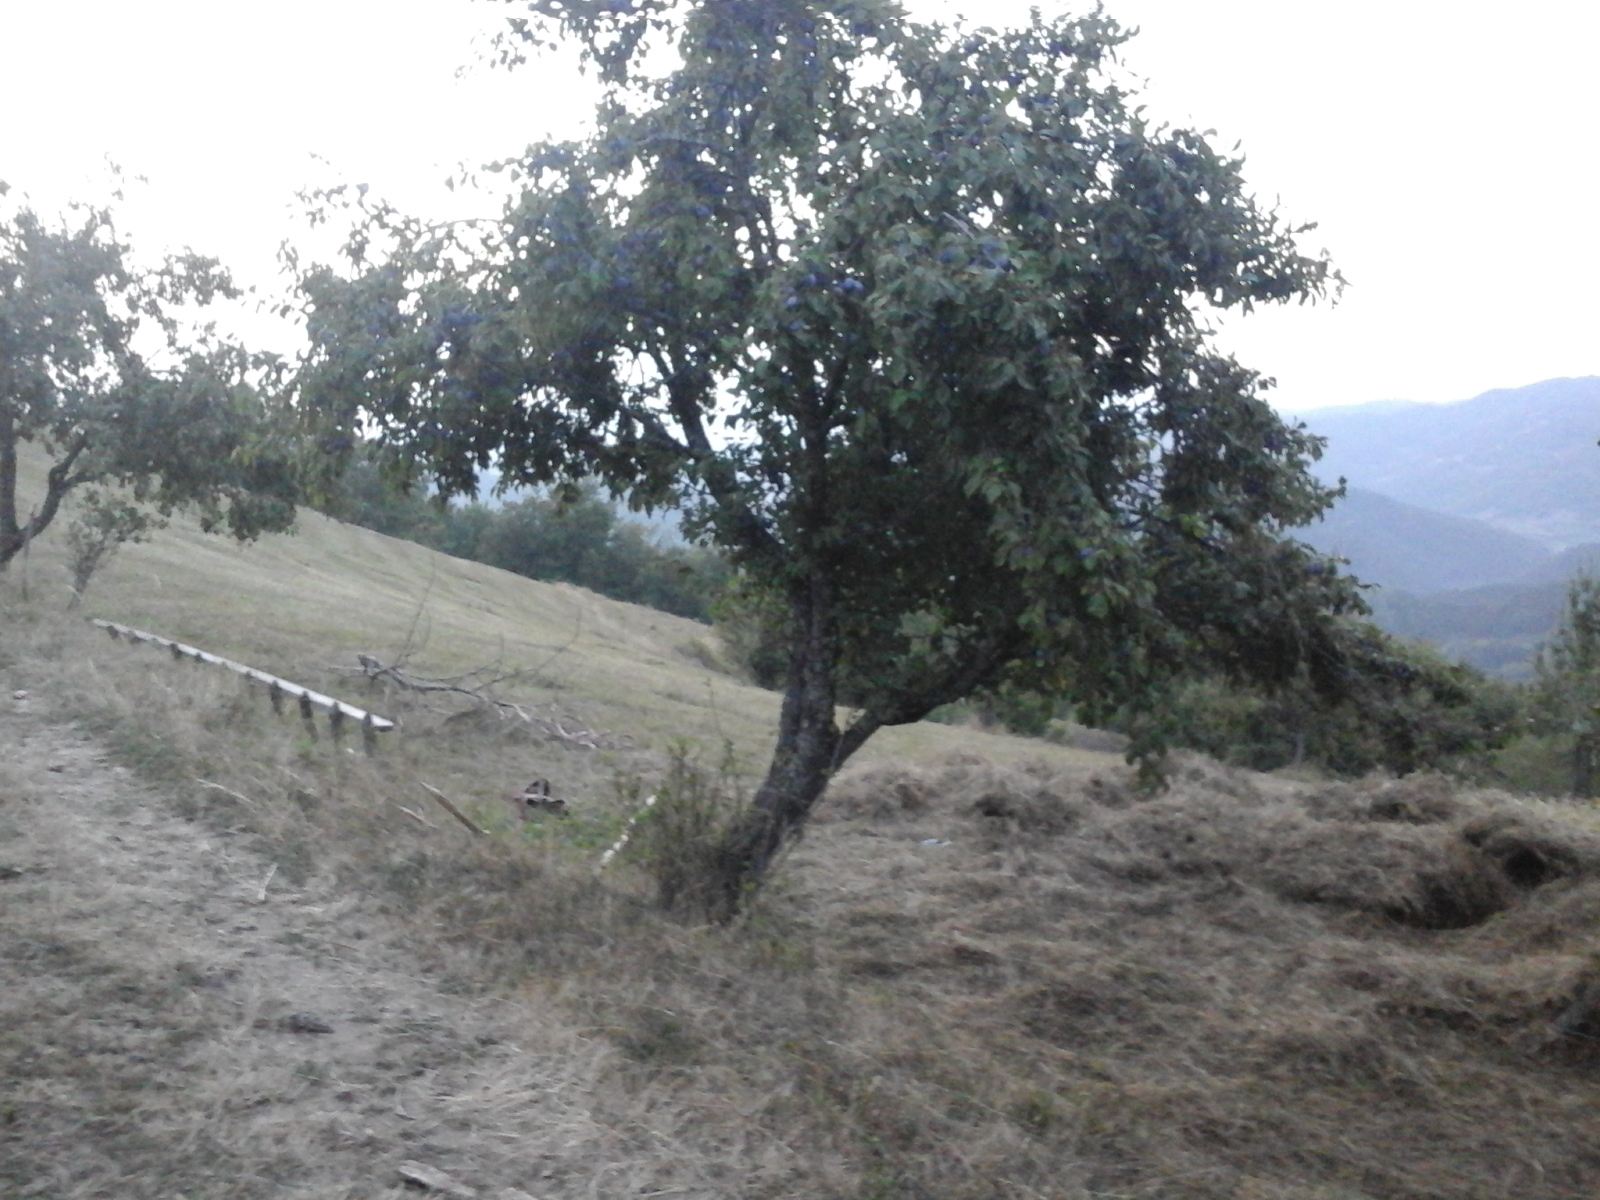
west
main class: Cropland
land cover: Nuts trees
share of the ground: > 75 %
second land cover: Grassland without tree/shrub cover
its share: > 75 %
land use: Agriculture (excluding fallow land and kitchen gardens)
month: September
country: RO
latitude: 47.4325
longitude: 24.1529
